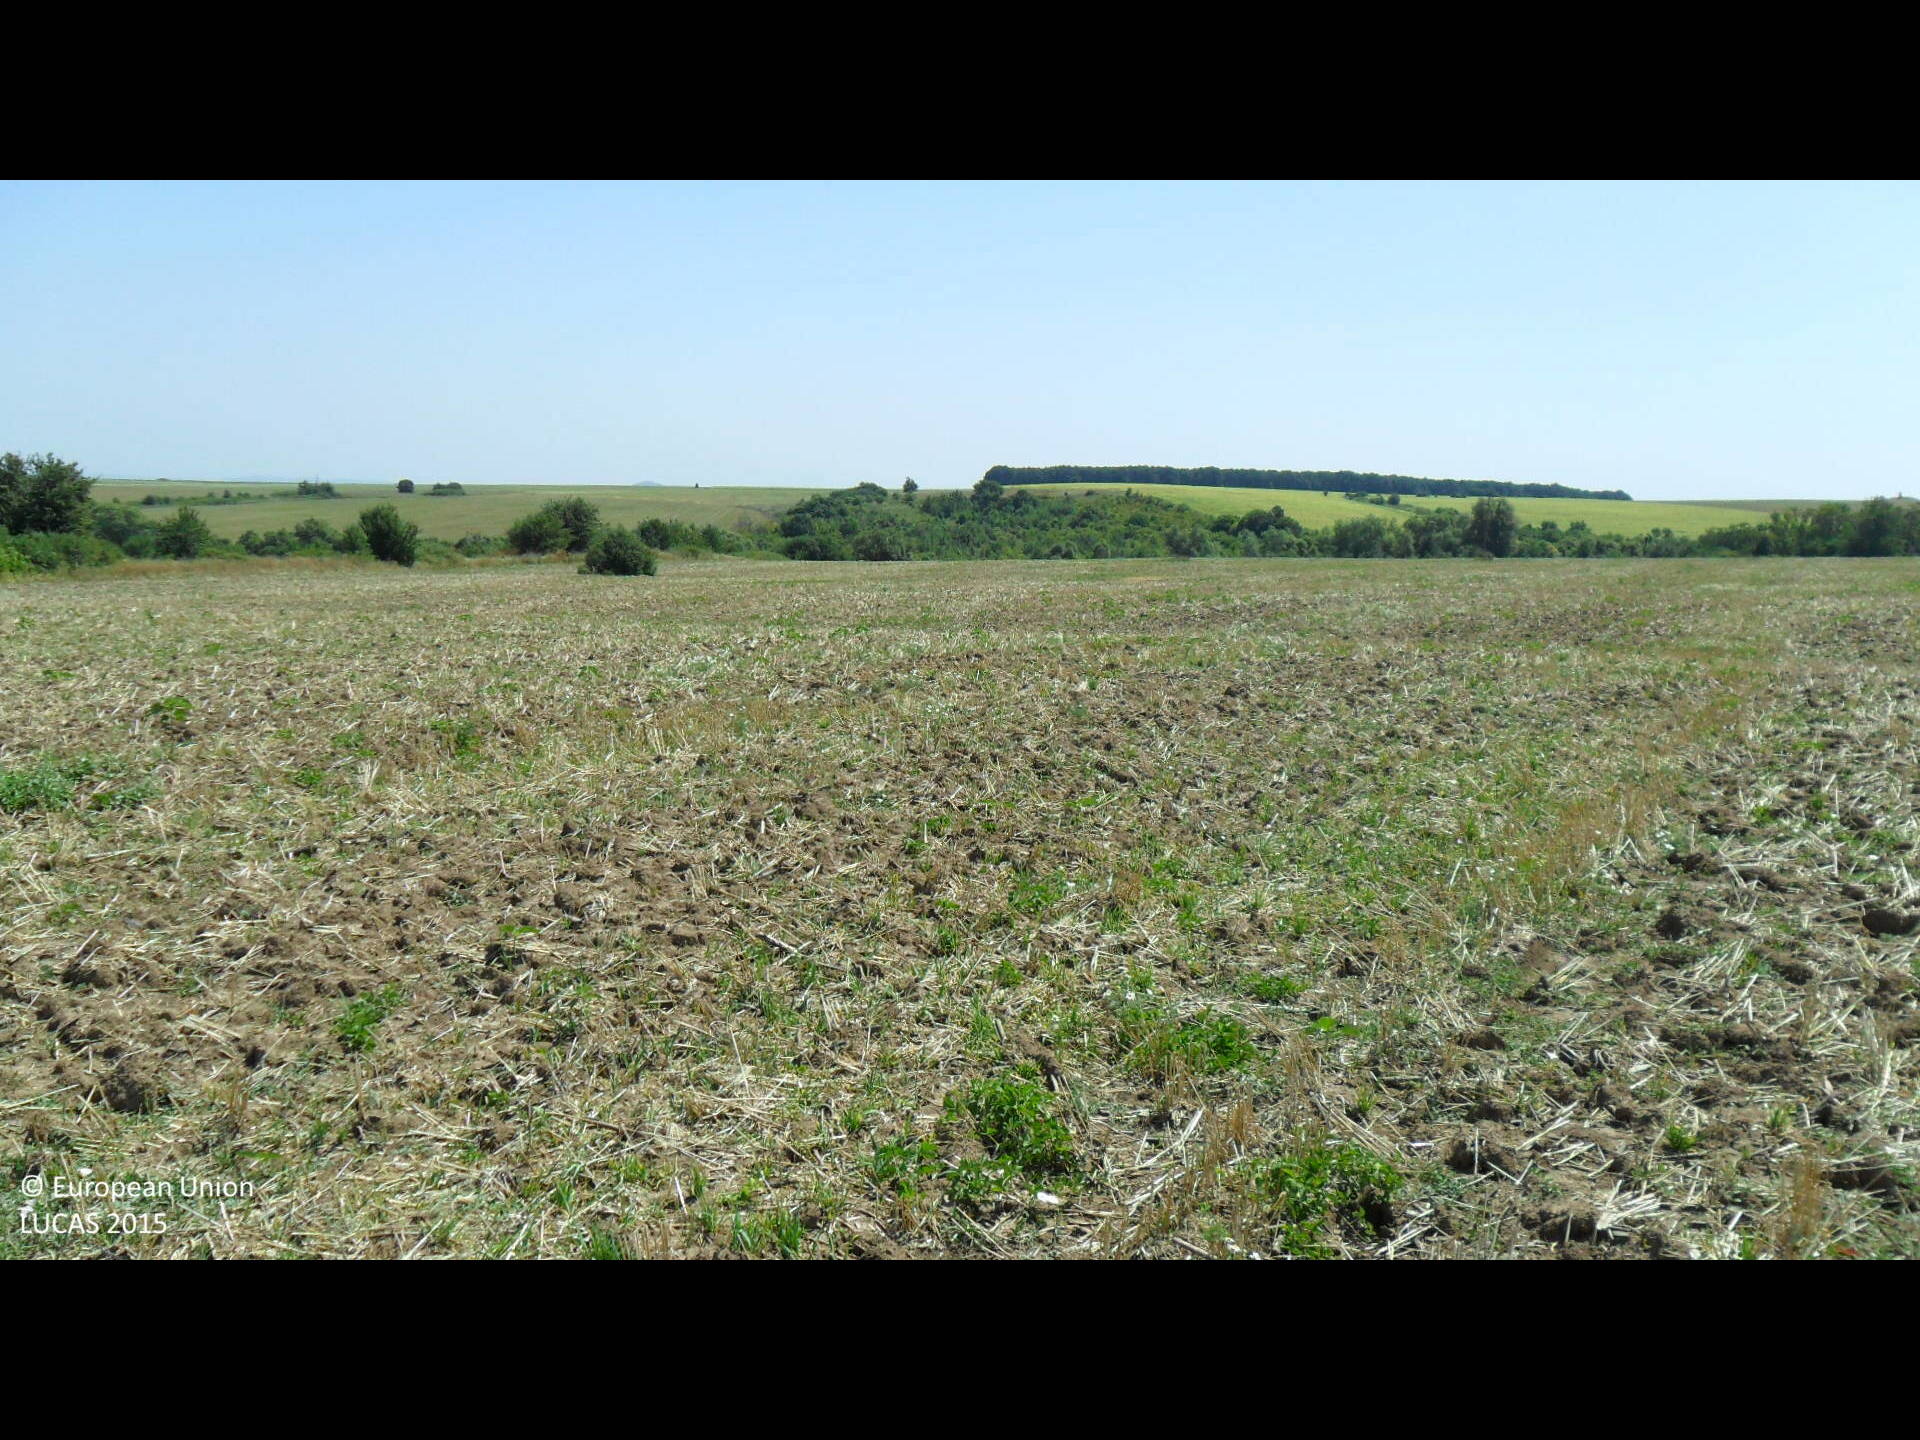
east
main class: Cropland
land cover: Barley
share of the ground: 10 - 25 %
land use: Agriculture (excluding fallow land and kitchen gardens)
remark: Harvested field
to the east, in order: Barley
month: August
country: BG
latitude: 43.3341
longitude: 26.1403
